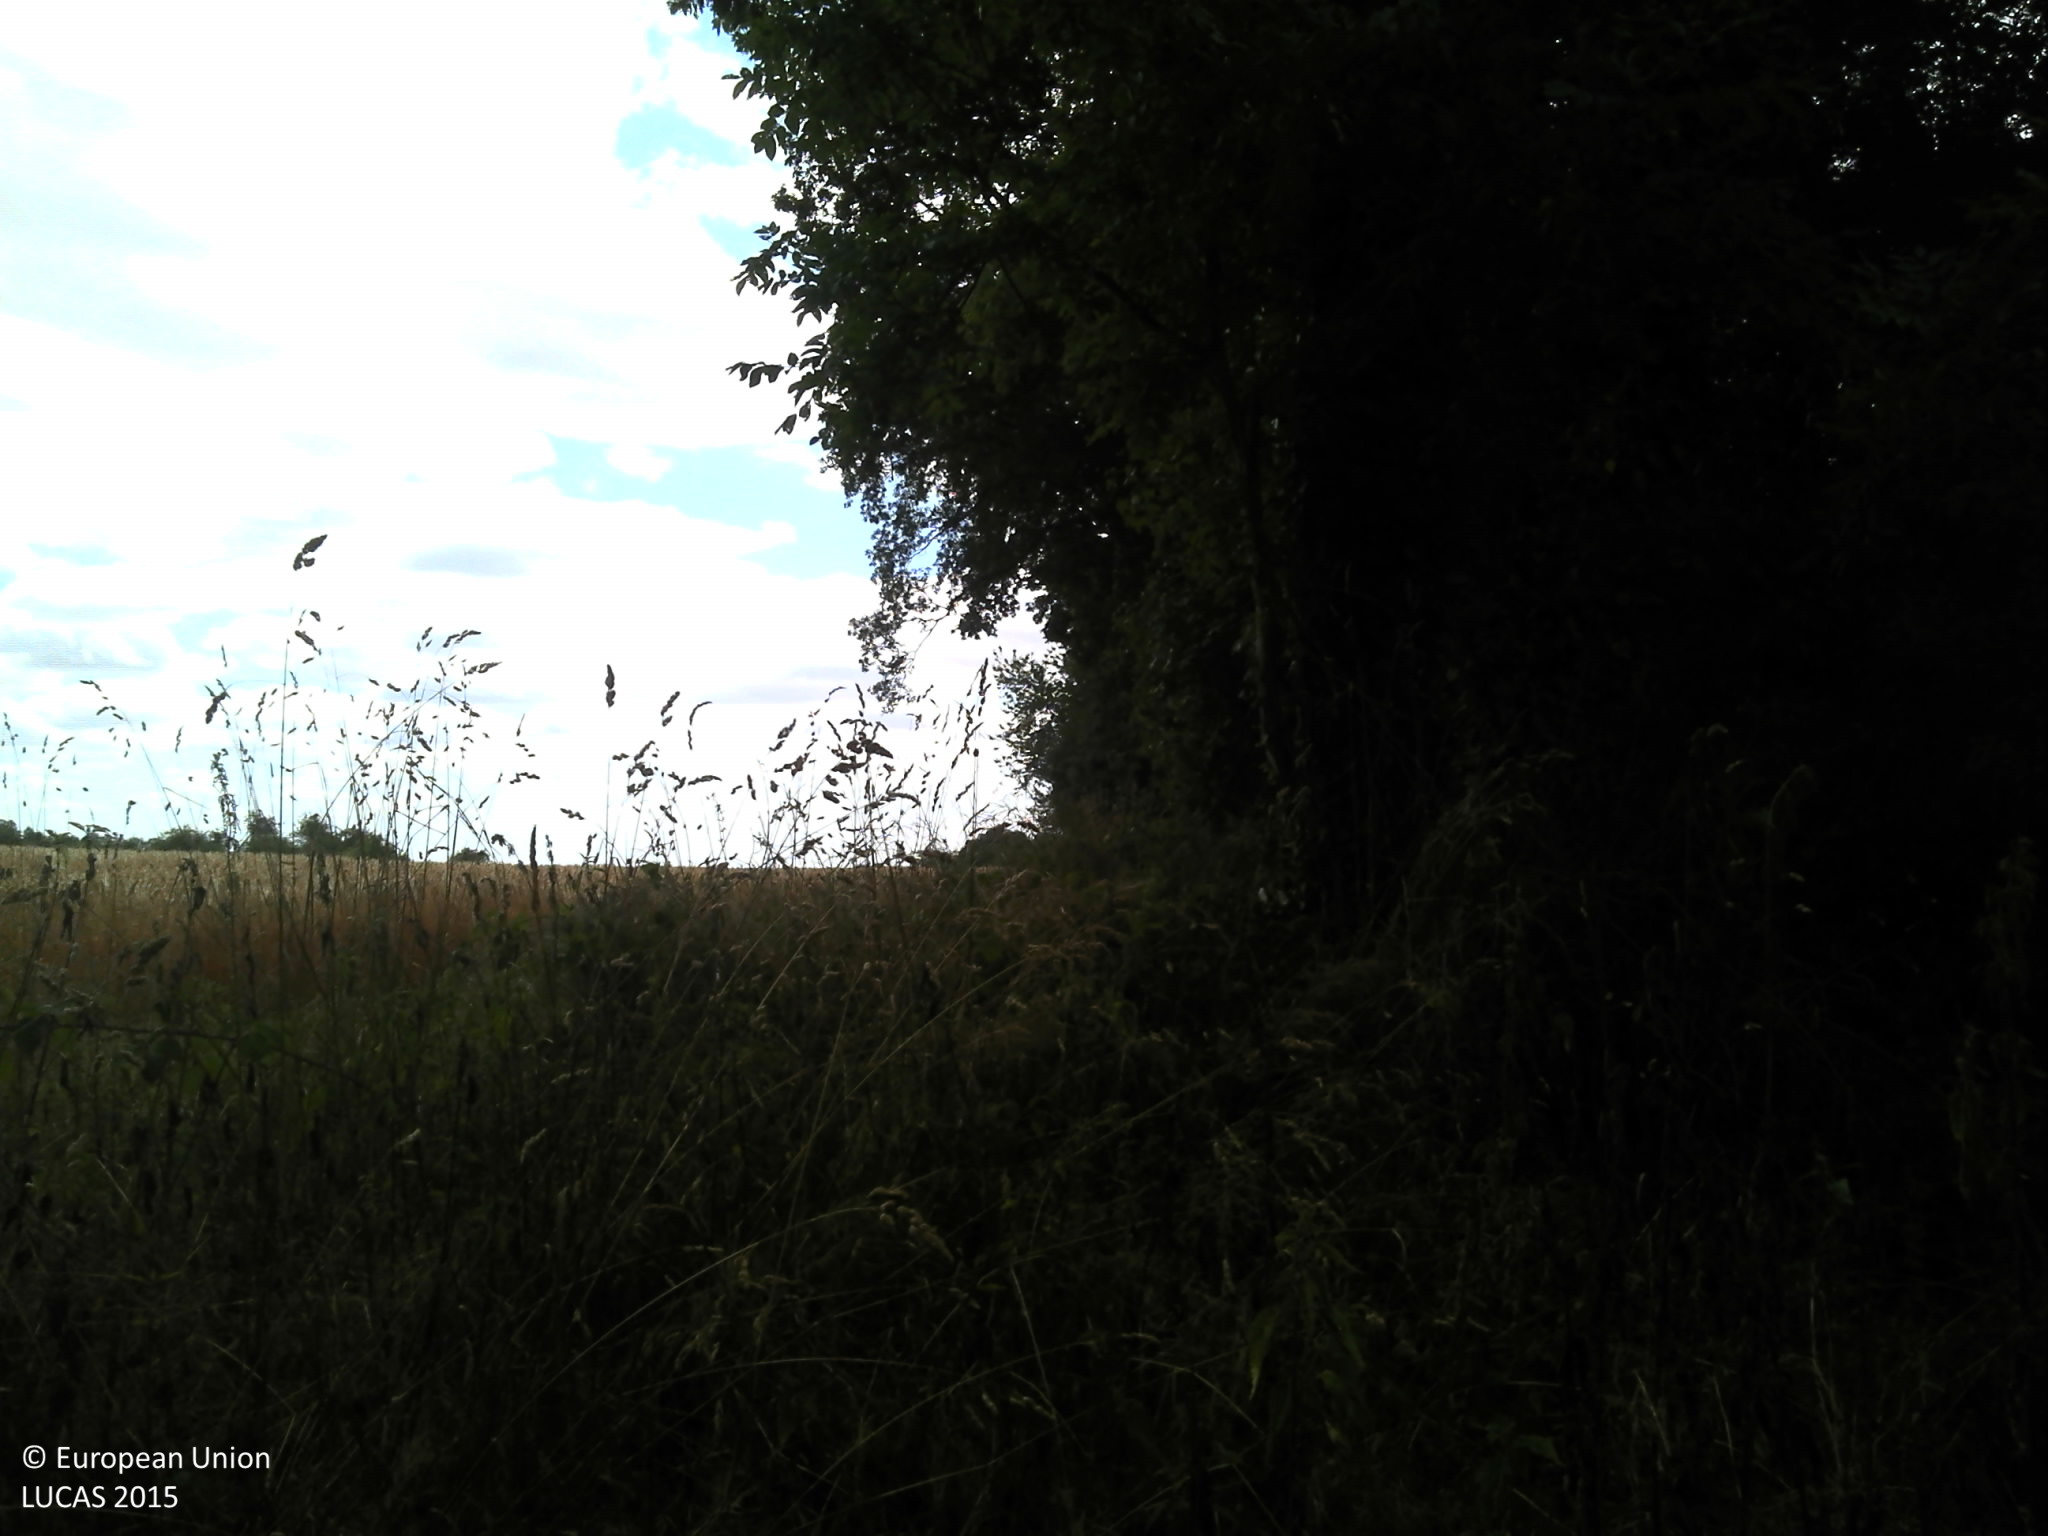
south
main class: Woodland
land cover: Broadleaved woodland
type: acidophilous oak and oak-birch forest
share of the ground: 50 - 75 %
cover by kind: broadleaved forest trees 70 %, herbaceous plants 20 %, consolidated bare surface 10 %
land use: Forestry
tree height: > 5 m
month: July
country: FR
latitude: 49.3259
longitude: 4.7824
